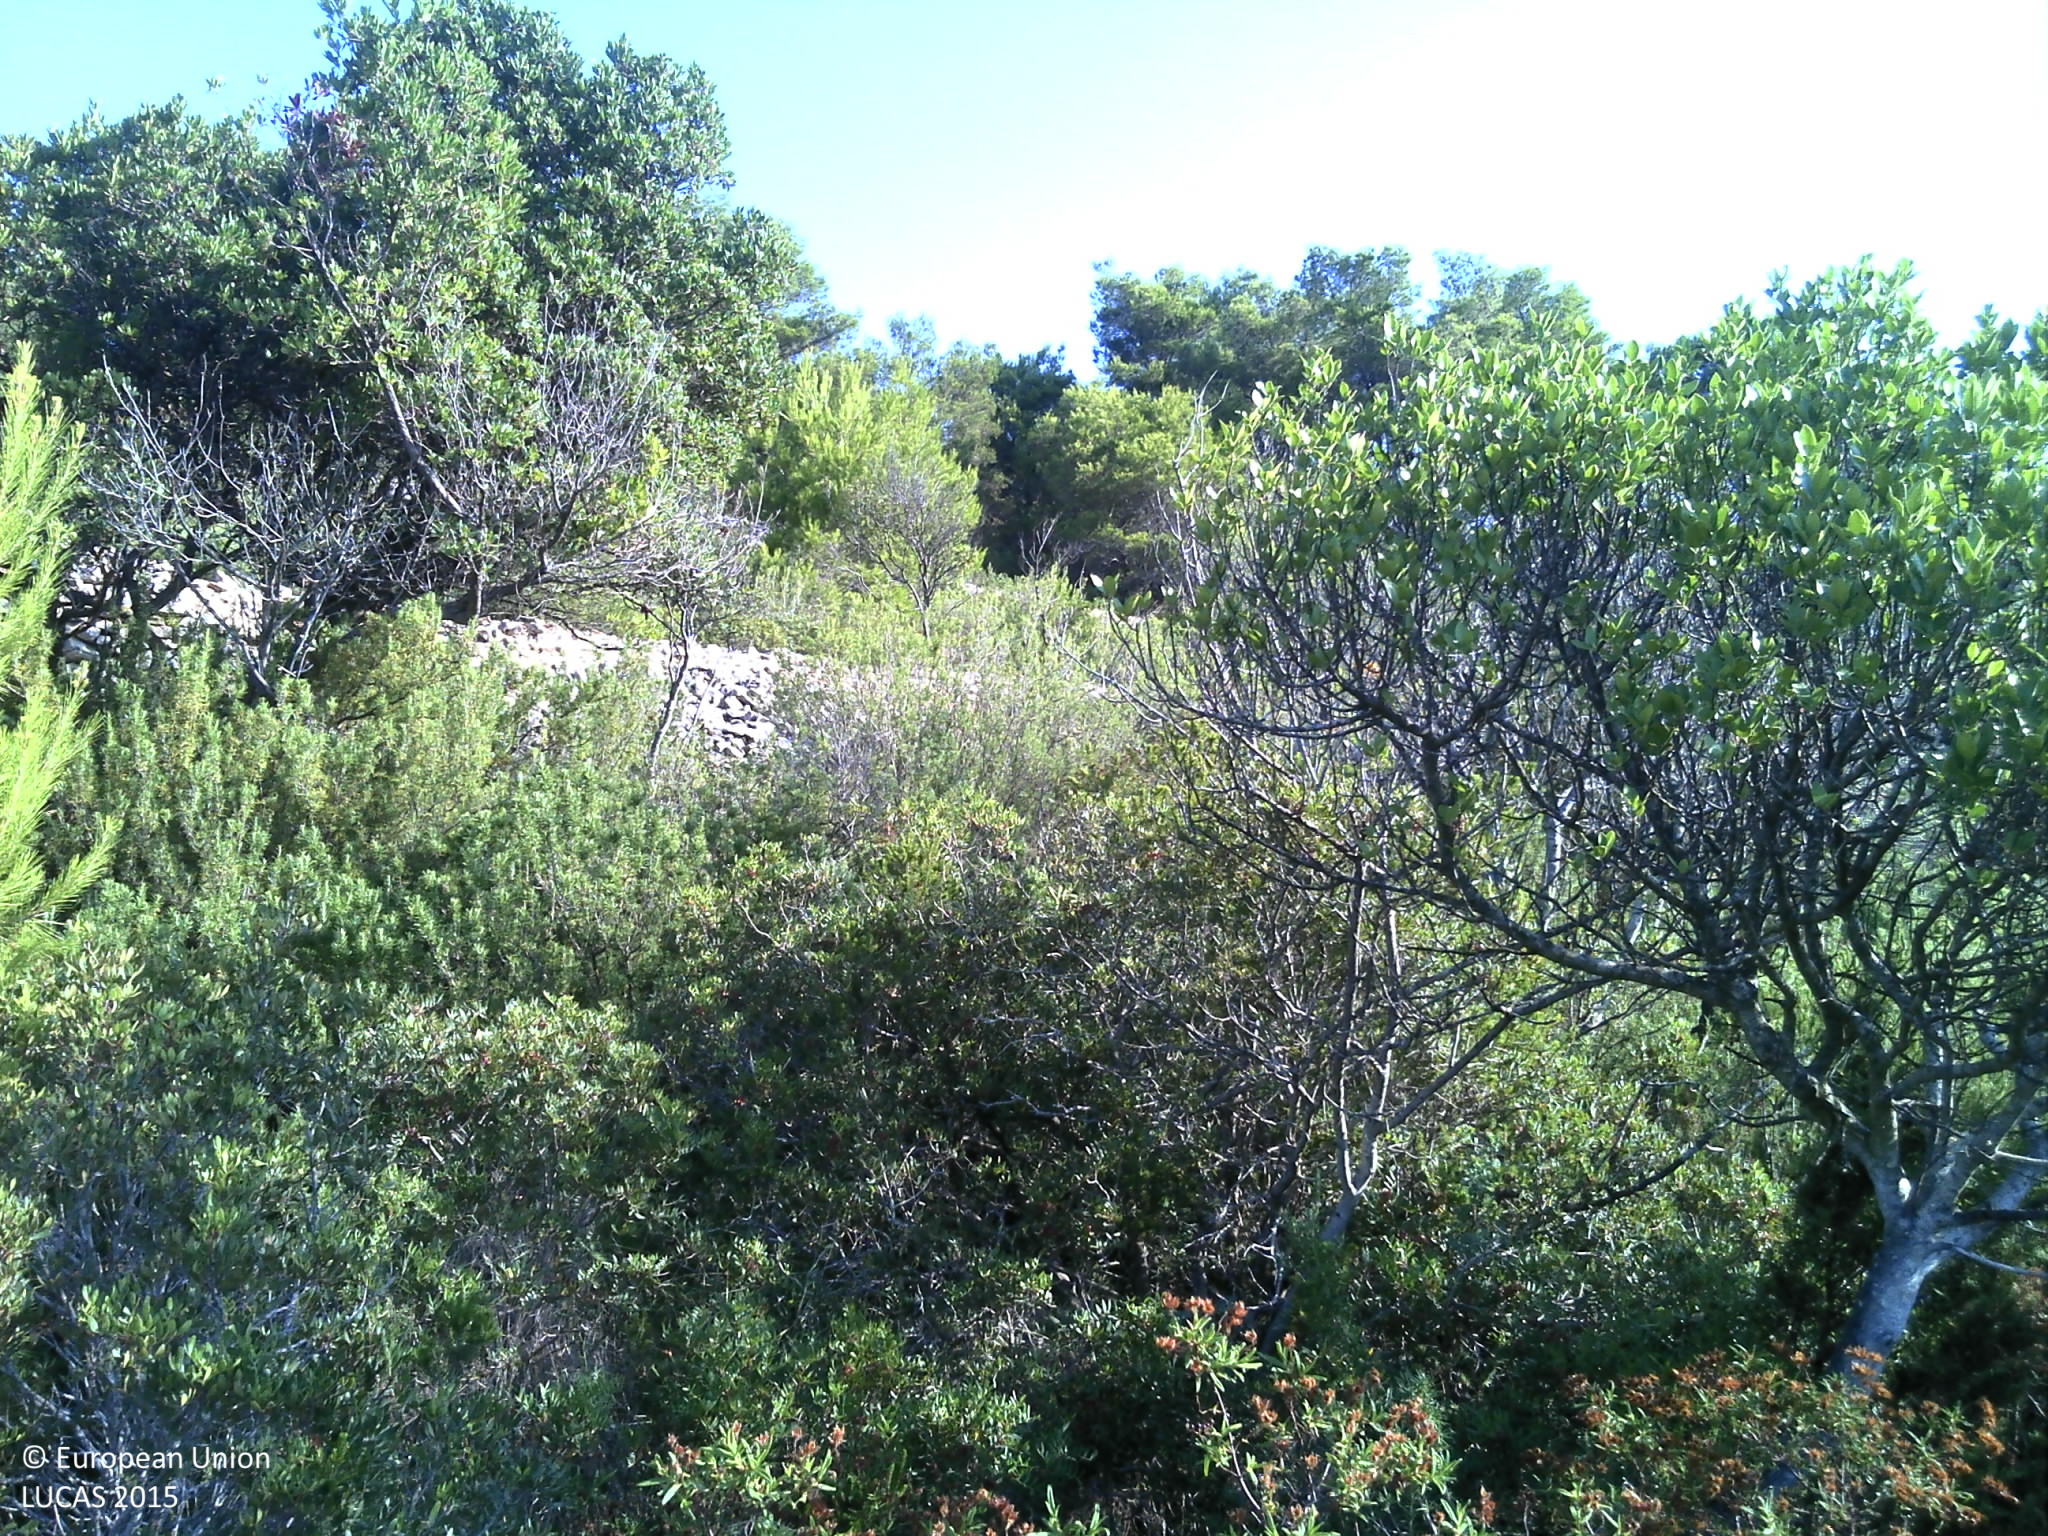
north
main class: Shrubland
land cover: Shrubland with sparse tree cover
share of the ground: > 75 %
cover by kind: shrubs 60 %, unconsolidated bare surface 20 %, herbaceous plants 10 %, coniferous forest trees 5 %, consolidated bare surface 5 %
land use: Abandoned areas
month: August
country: HR
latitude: 43.0456
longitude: 16.1633
